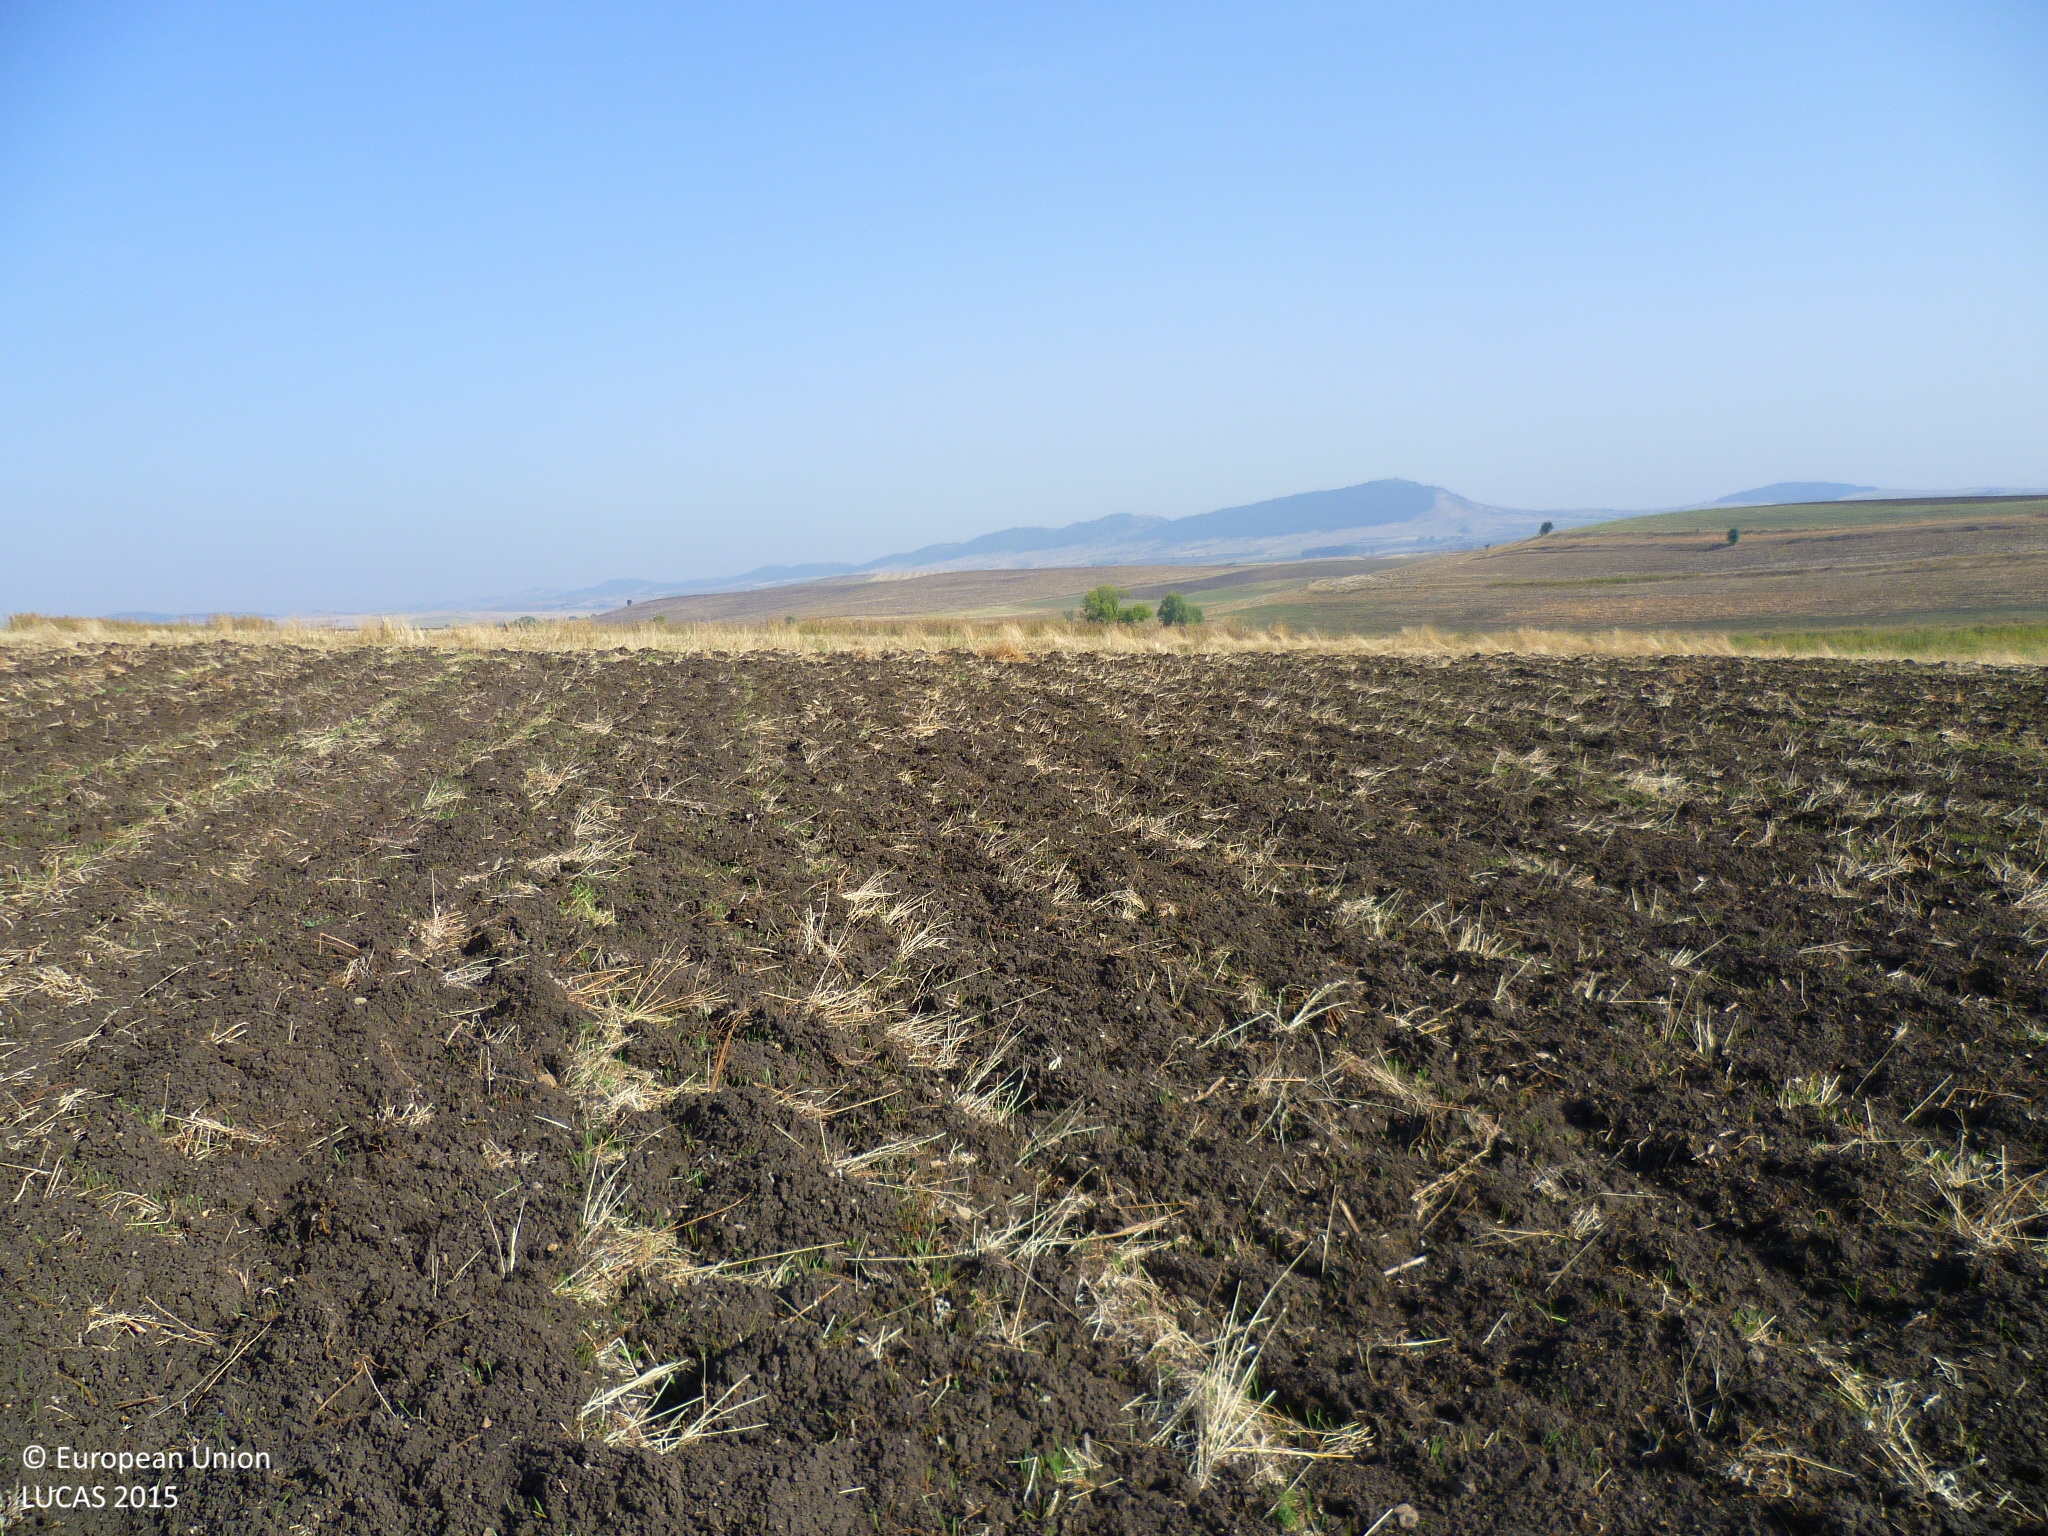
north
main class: Cropland
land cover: Rape and turnip rape
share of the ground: < 10 %
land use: Agriculture (excluding fallow land and kitchen gardens)
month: September
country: BG
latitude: 42.6561
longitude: 22.9720
